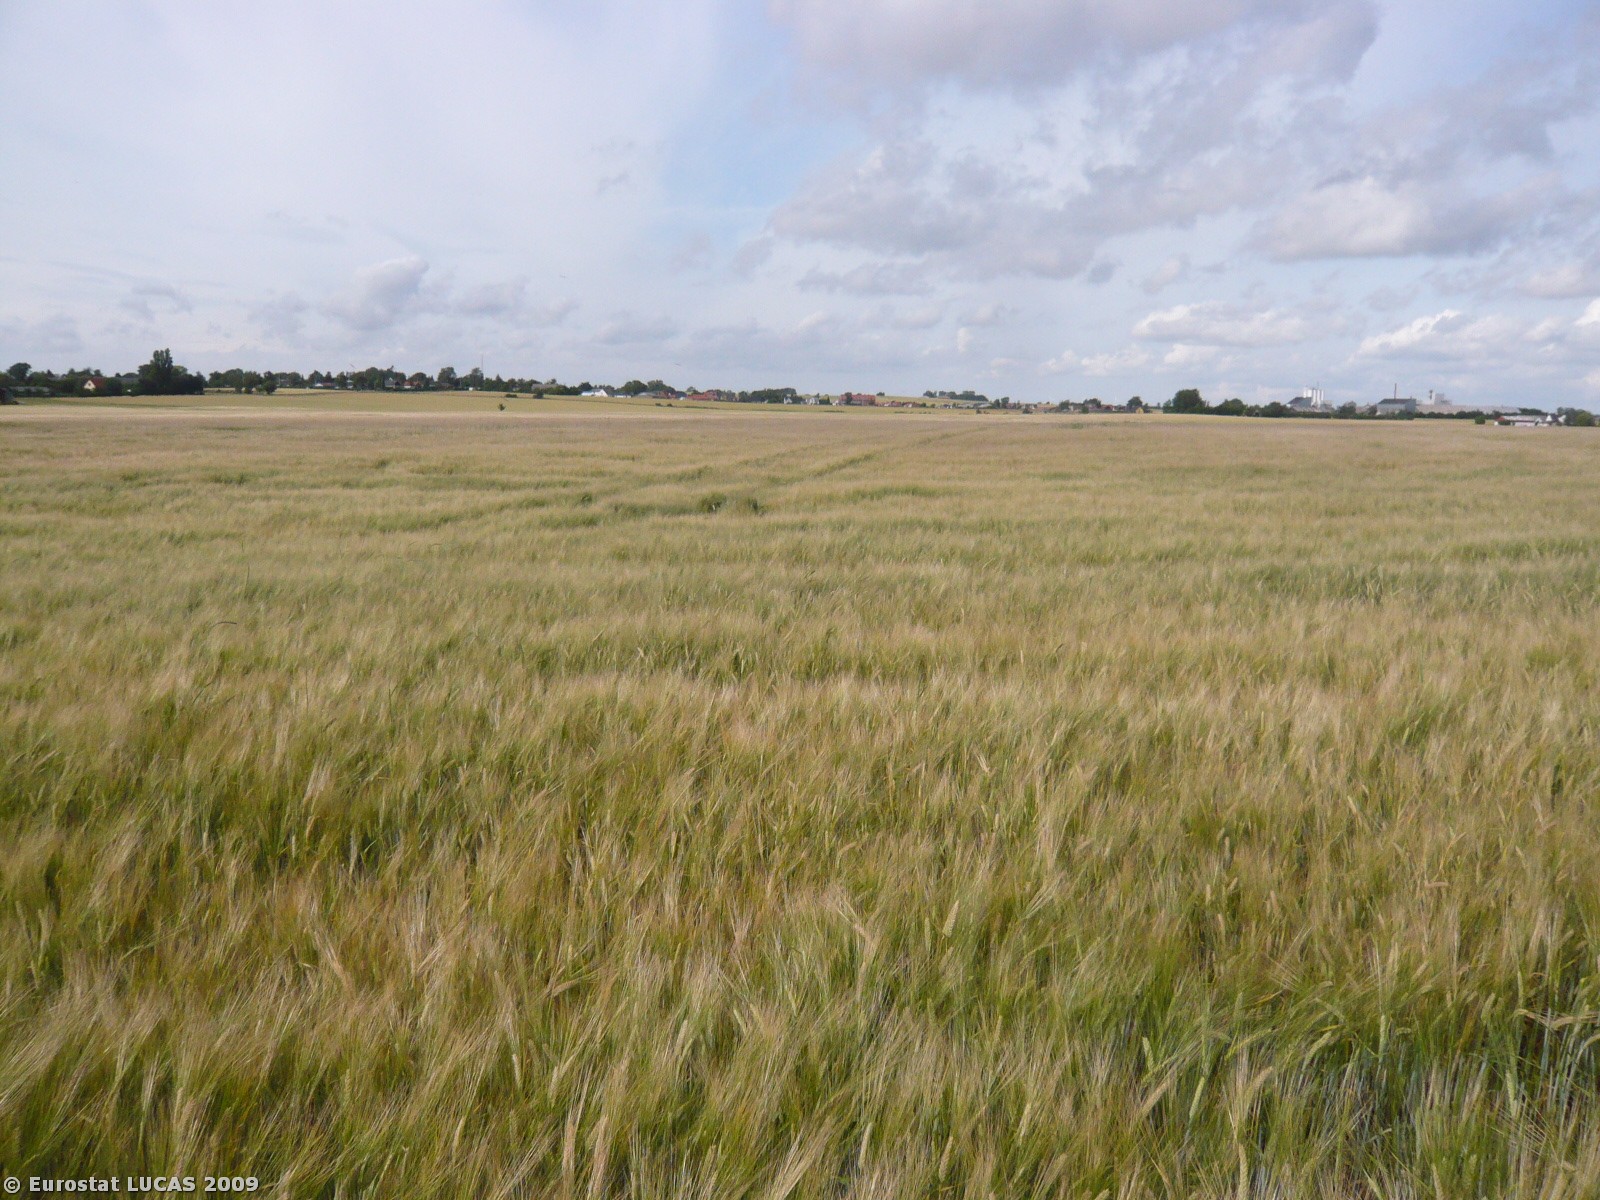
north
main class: Cropland
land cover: Barley
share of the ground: > 75 %
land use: Agriculture (excluding fallow land and kitchen gardens)
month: July
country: DK
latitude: 55.4267
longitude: 11.2472
